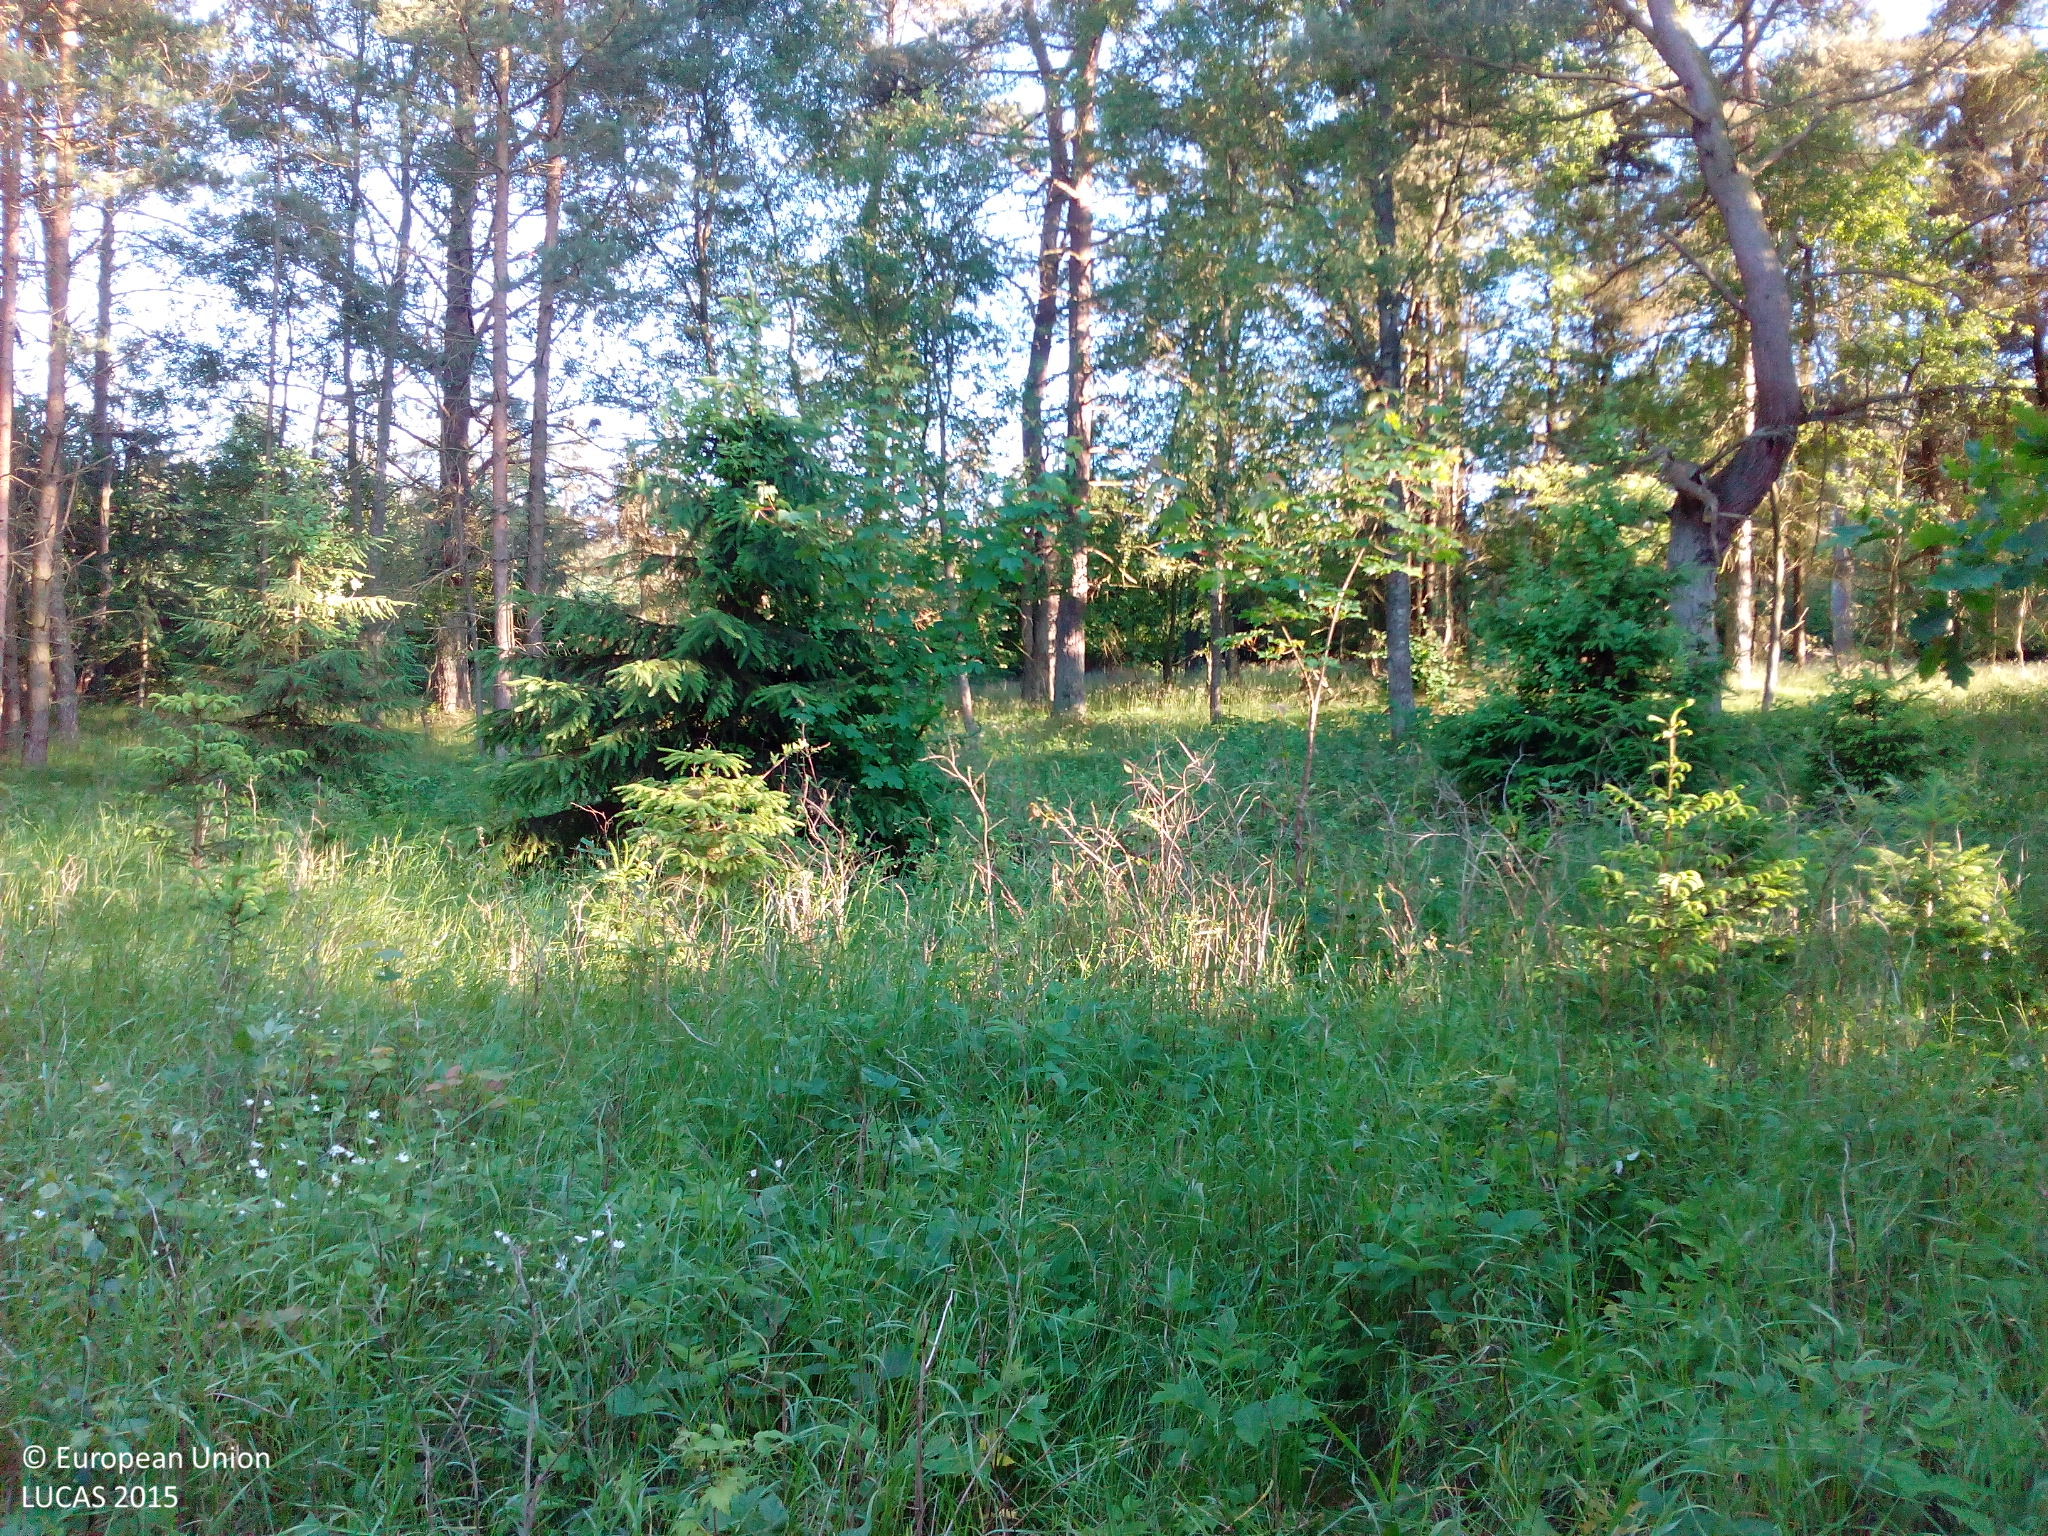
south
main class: Woodland
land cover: Other mixed woodland
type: hemiboreal forest and nemoral coniferous forest and mixed broadleaved-coniferous forest
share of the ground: 10 - 25 %
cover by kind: herbaceous plants 65 %, broadleaved forest trees 15 %, coniferous forest trees 10 %, shrubs 10 %
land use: Forestry
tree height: > 5 m
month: July
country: DK
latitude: 56.4913
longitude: 10.7299
